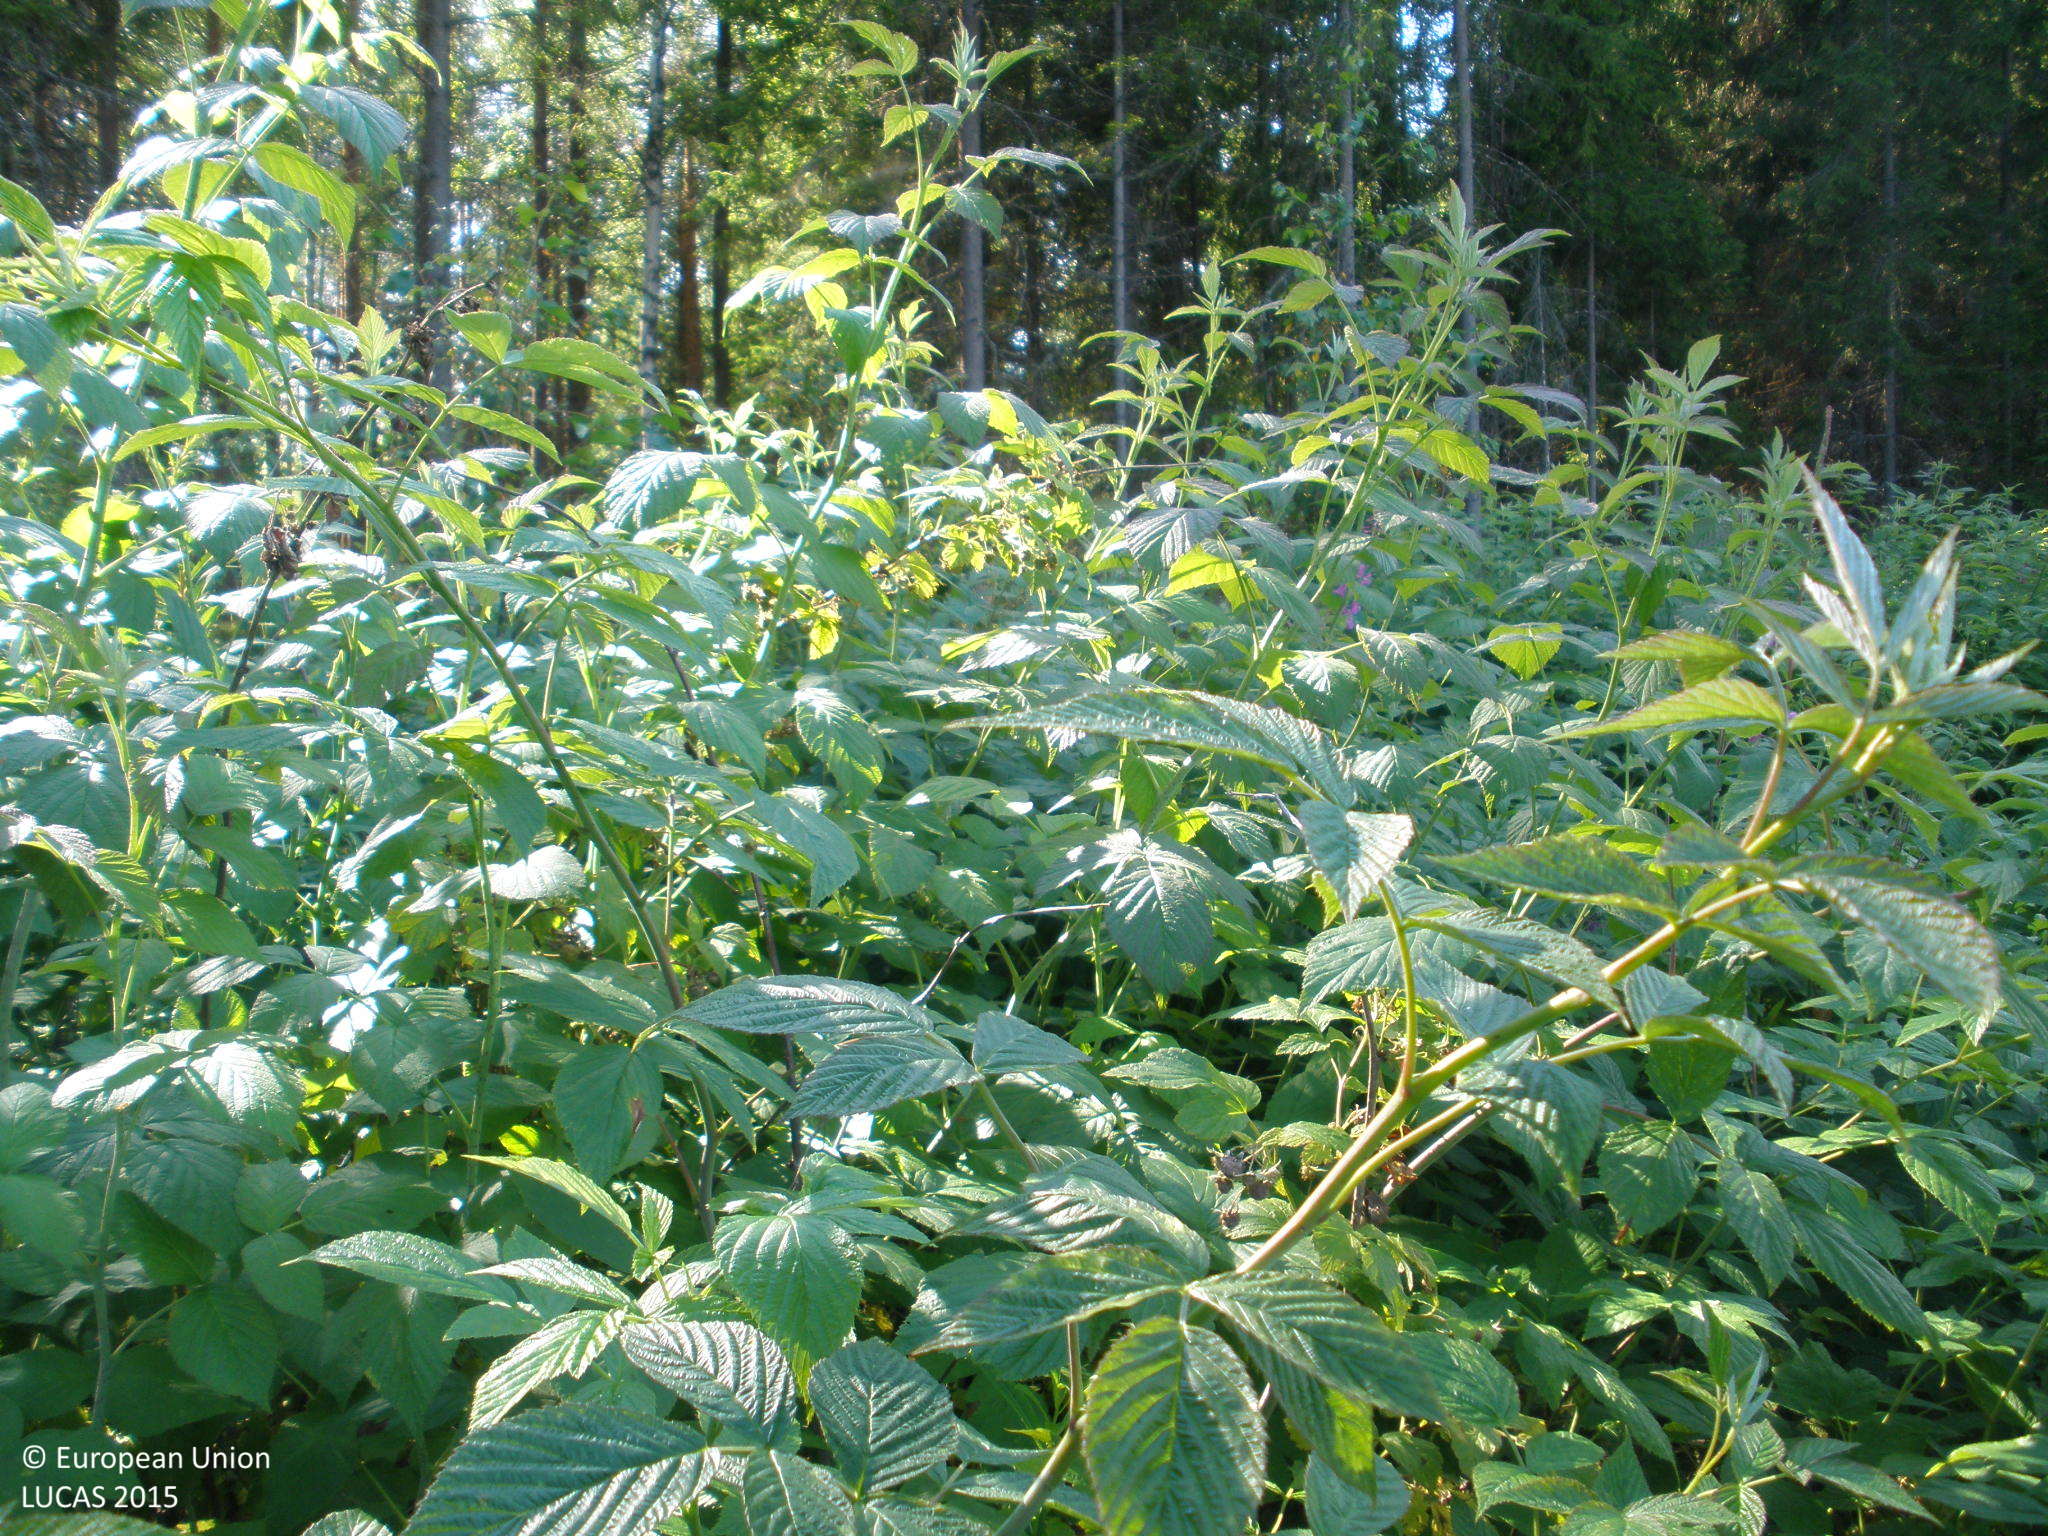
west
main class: Shrubland
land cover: Shrubland with sparse tree cover
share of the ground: > 75 %
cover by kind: shrubs 90 %, broadleaved forest trees 5 %, herbaceous plants 5 %
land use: Forestry
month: August
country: FI
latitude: 60.8250
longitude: 24.2778
